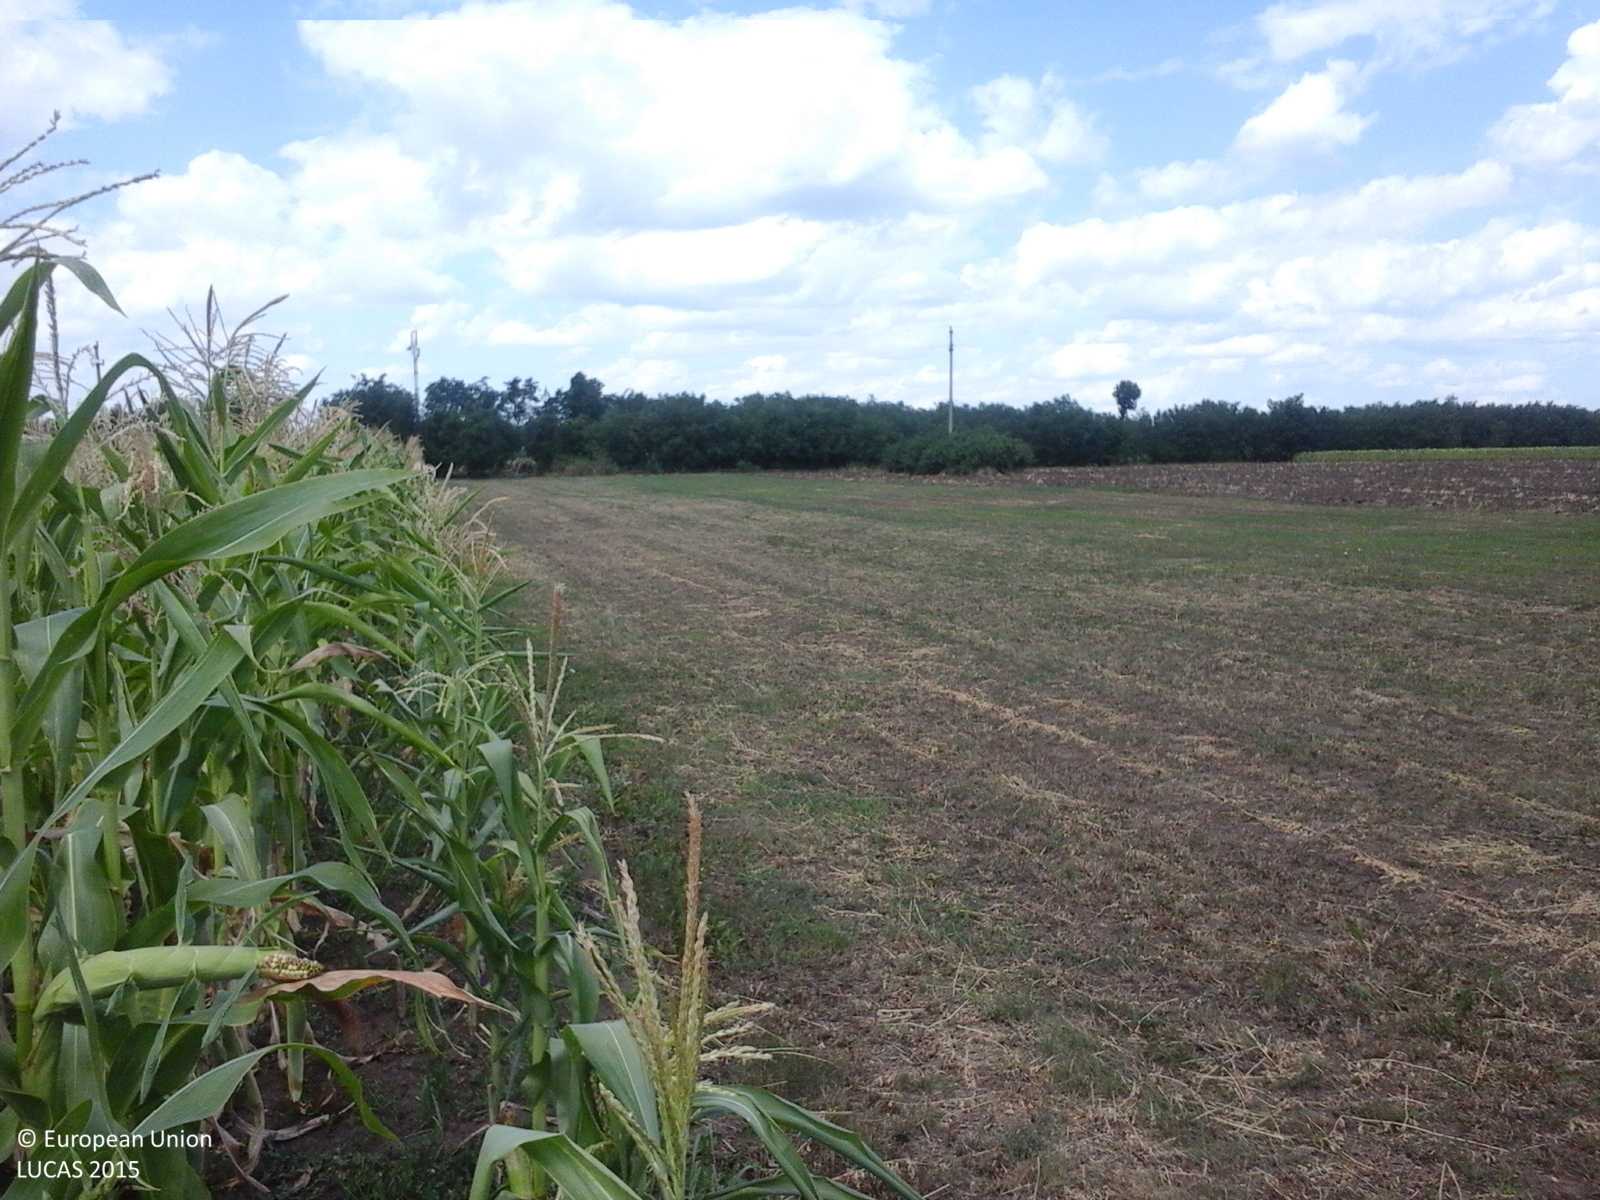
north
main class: Cropland
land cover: Maize
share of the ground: > 75 %
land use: Agriculture (excluding fallow land and kitchen gardens)
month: July
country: RO
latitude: 46.4703
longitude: 27.8727
